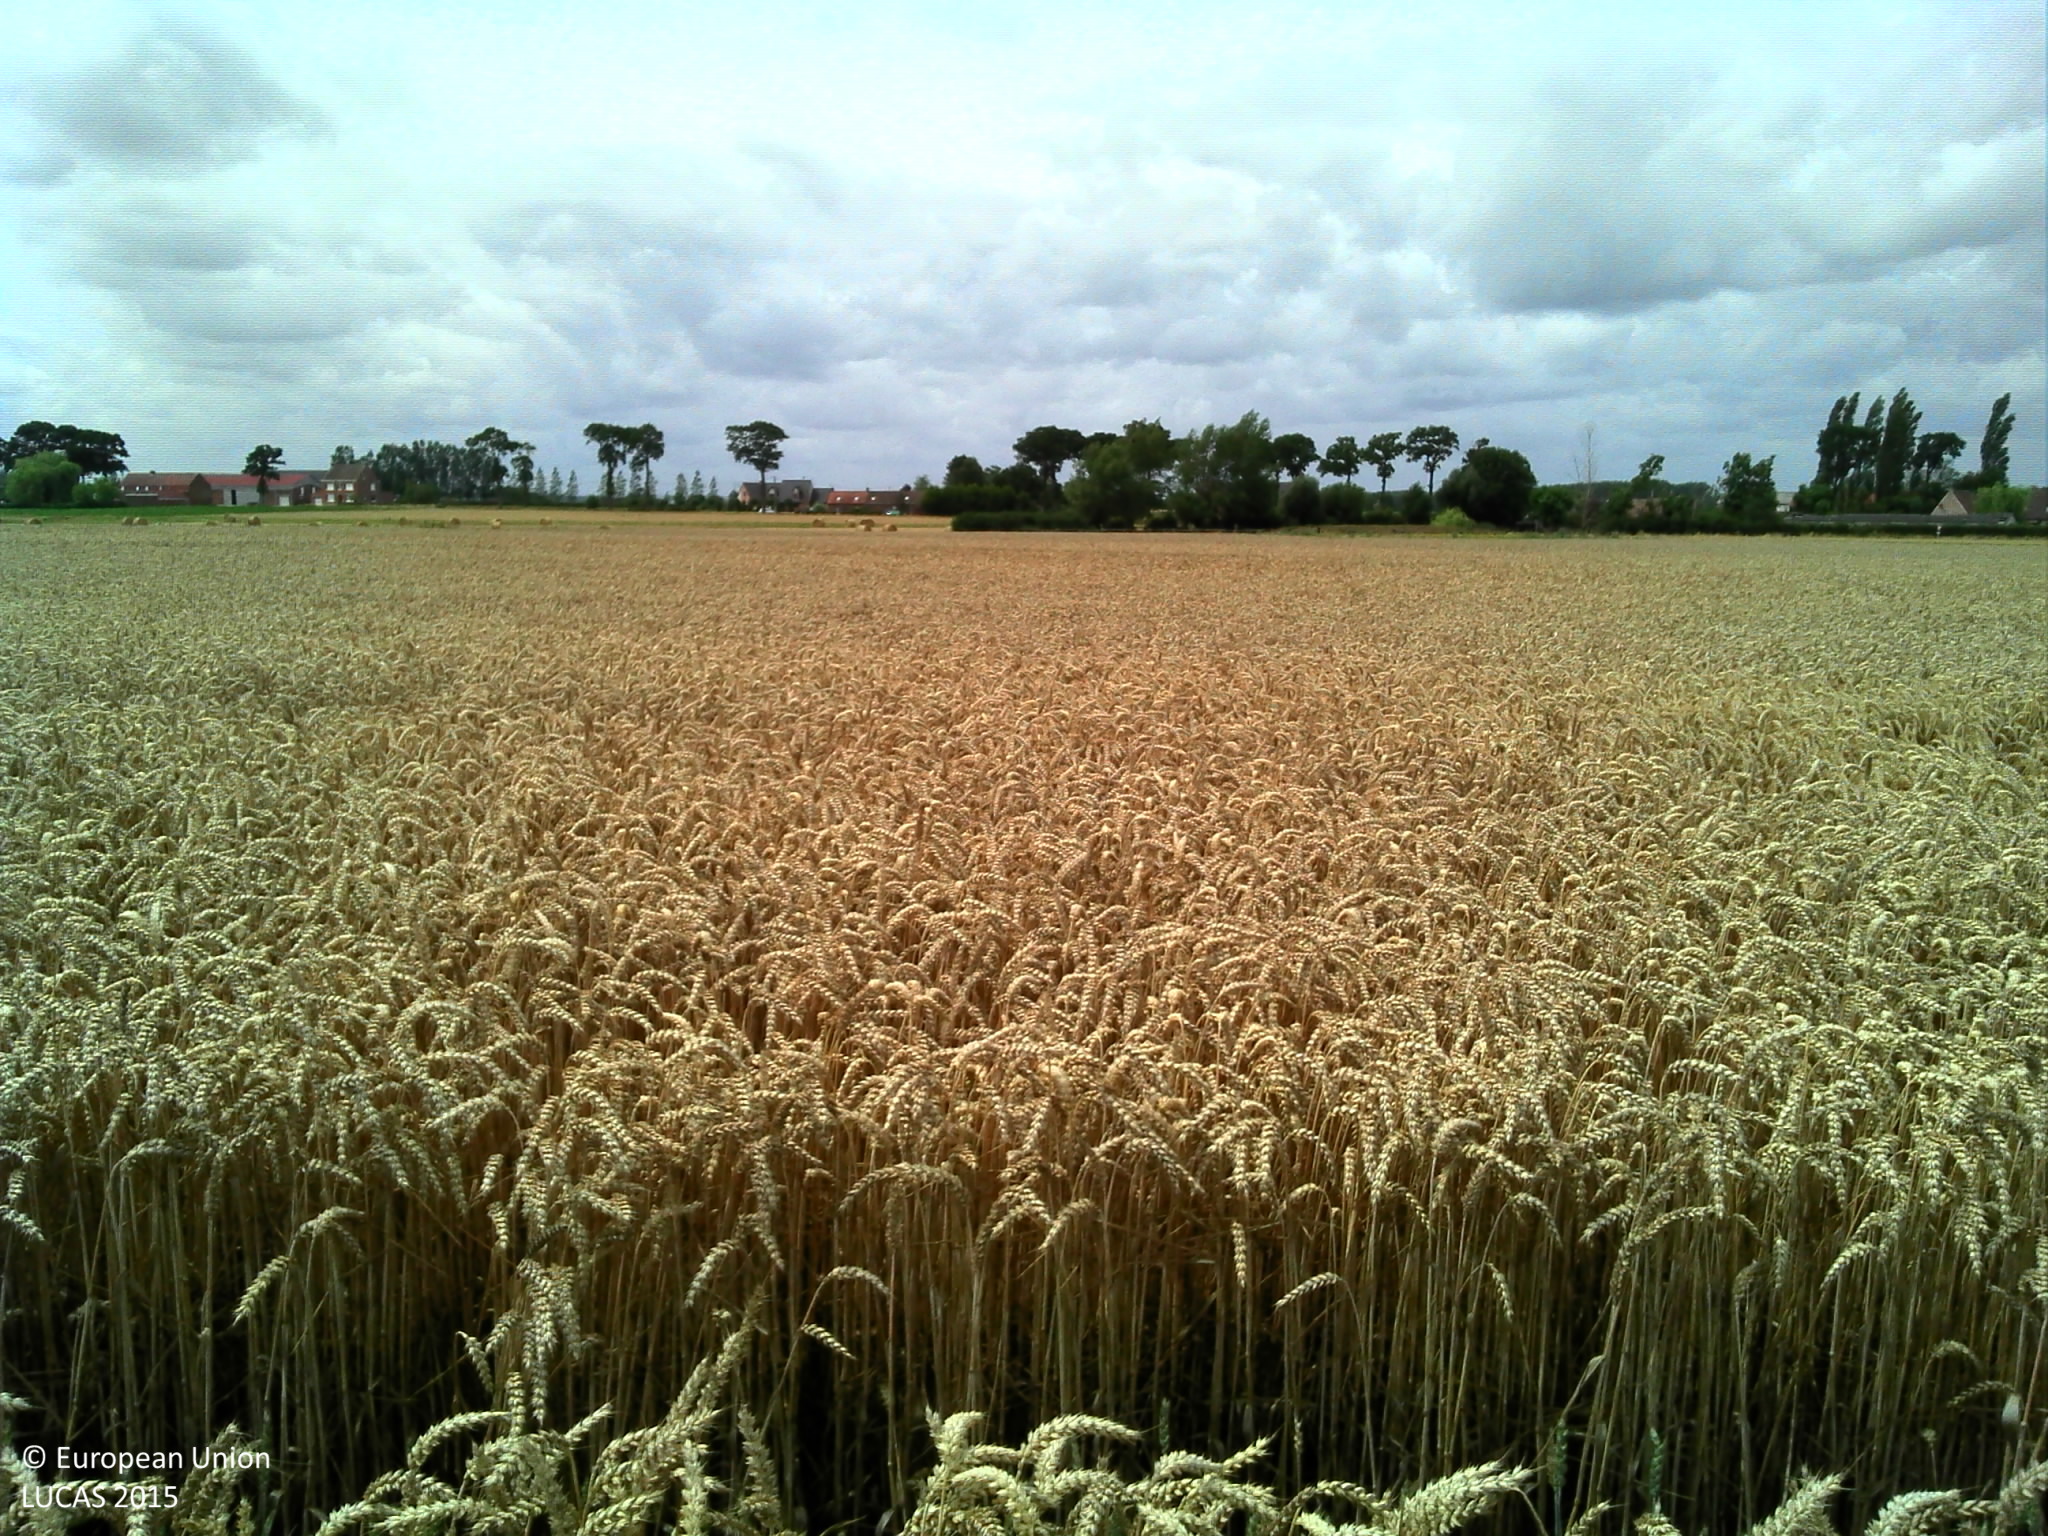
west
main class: Cropland
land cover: Common wheat
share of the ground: > 75 %
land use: Agriculture (excluding fallow land and kitchen gardens)
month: July
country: FR
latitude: 50.7632
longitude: 2.4302
